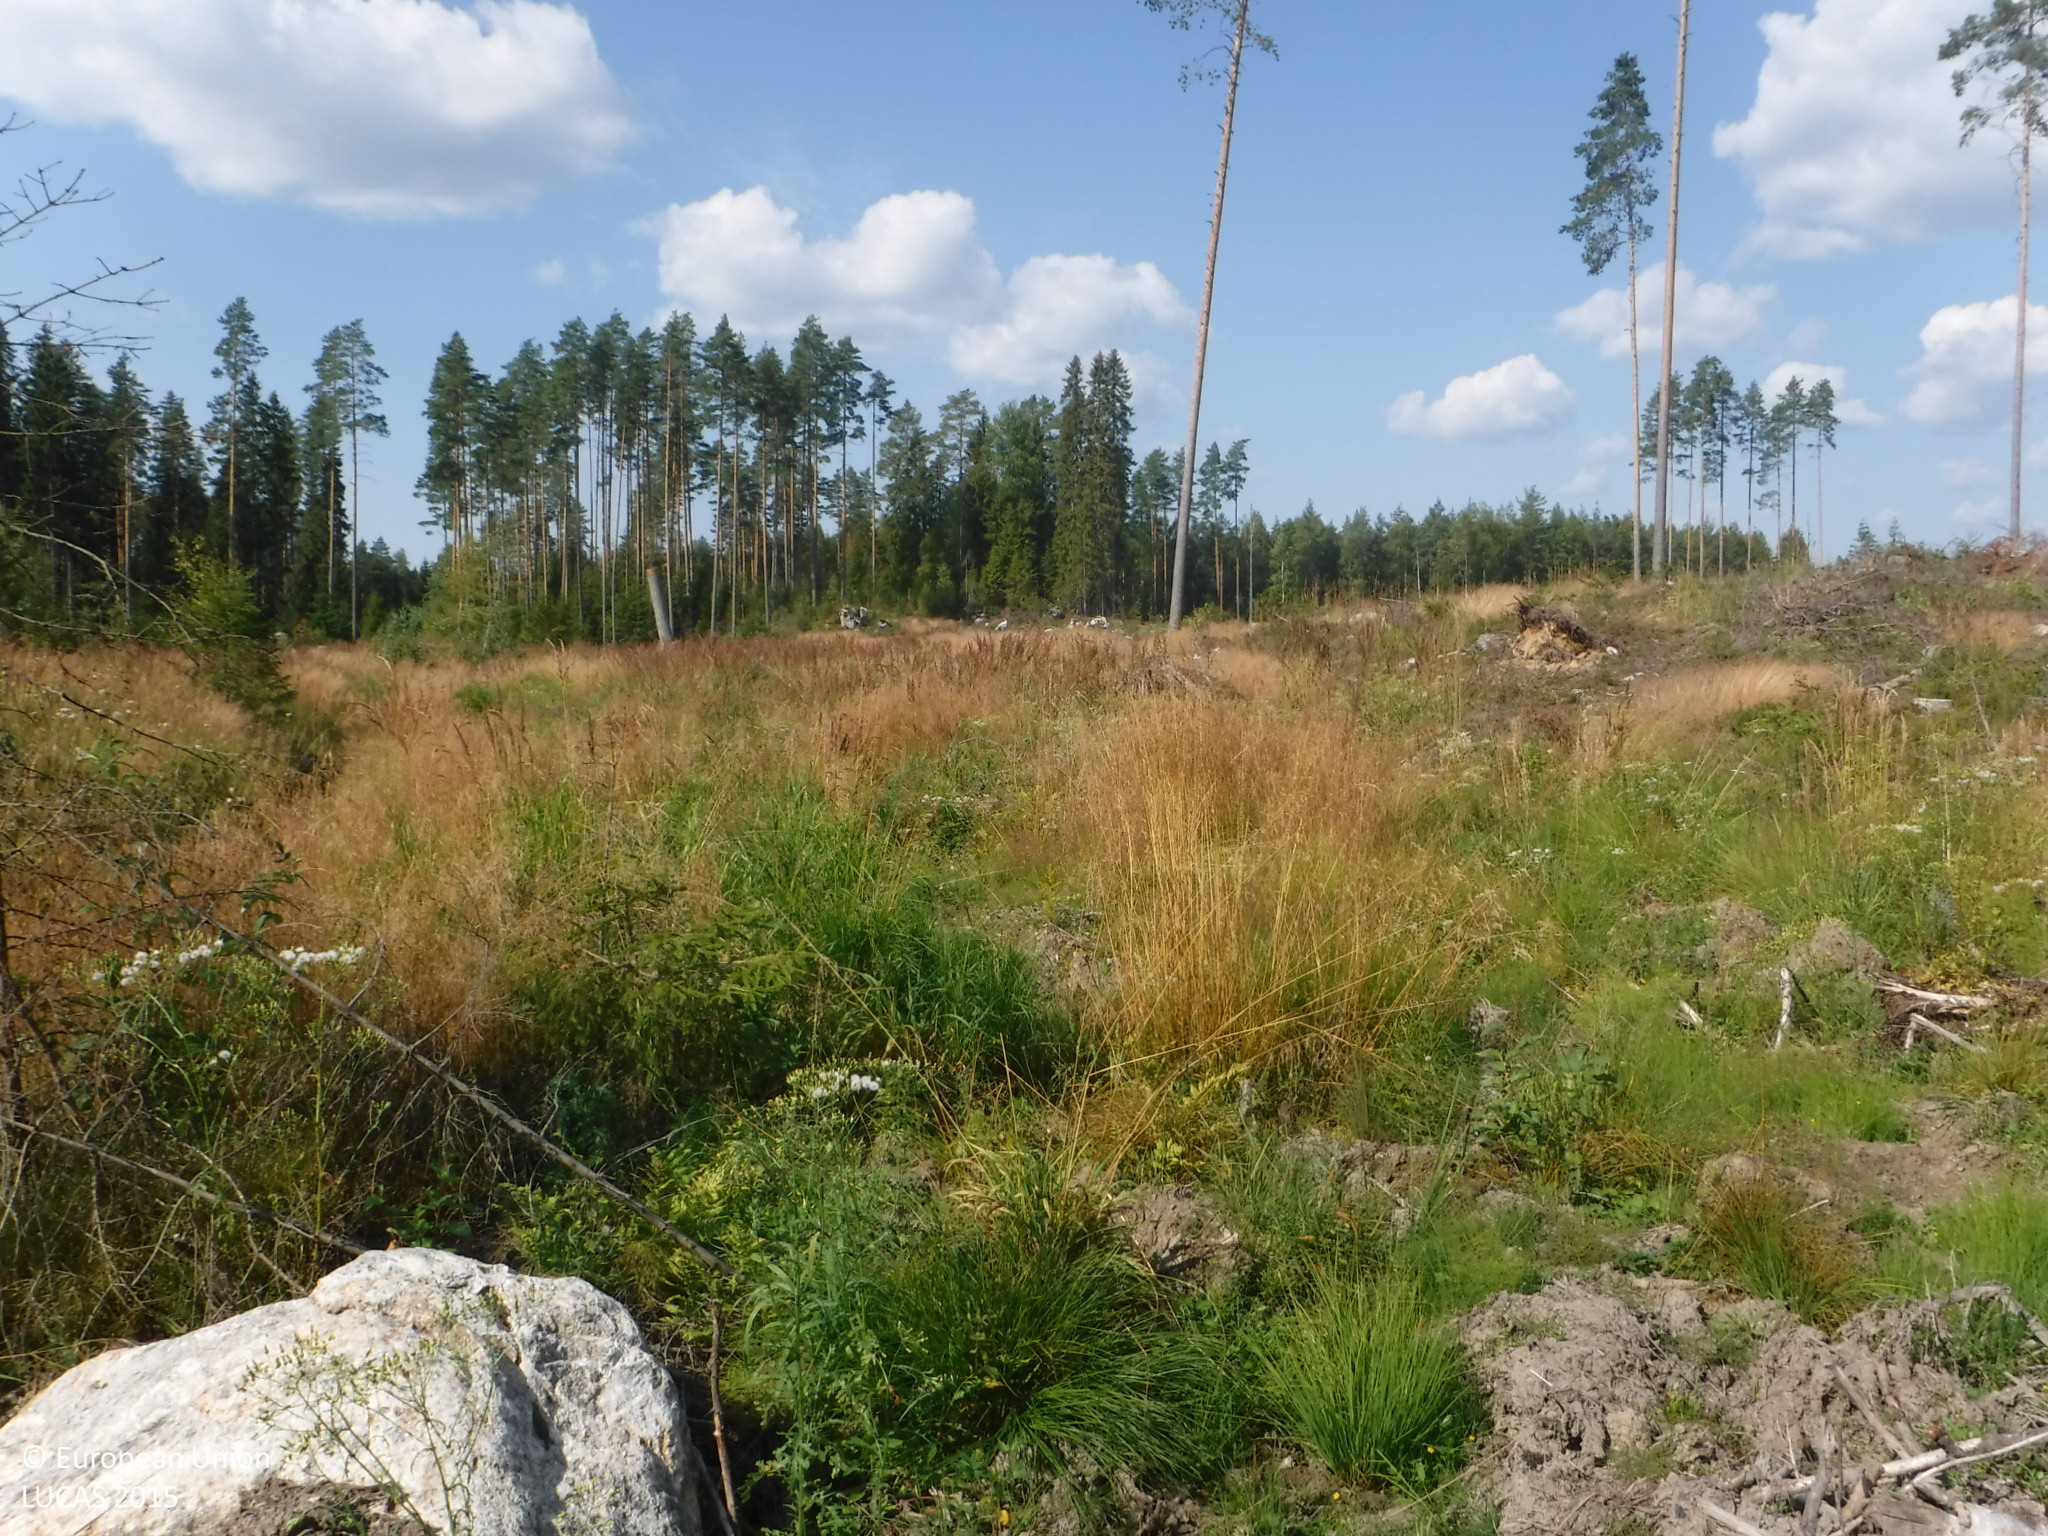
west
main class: Grassland
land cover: Spontaneously vegetated surfaces
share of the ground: 50 - 75 %
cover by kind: herbaceous plants 50 %, unconsolidated bare surface 35 %, shrubs 5 %
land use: Forestry
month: August
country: FI
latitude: 61.2039
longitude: 23.1966
